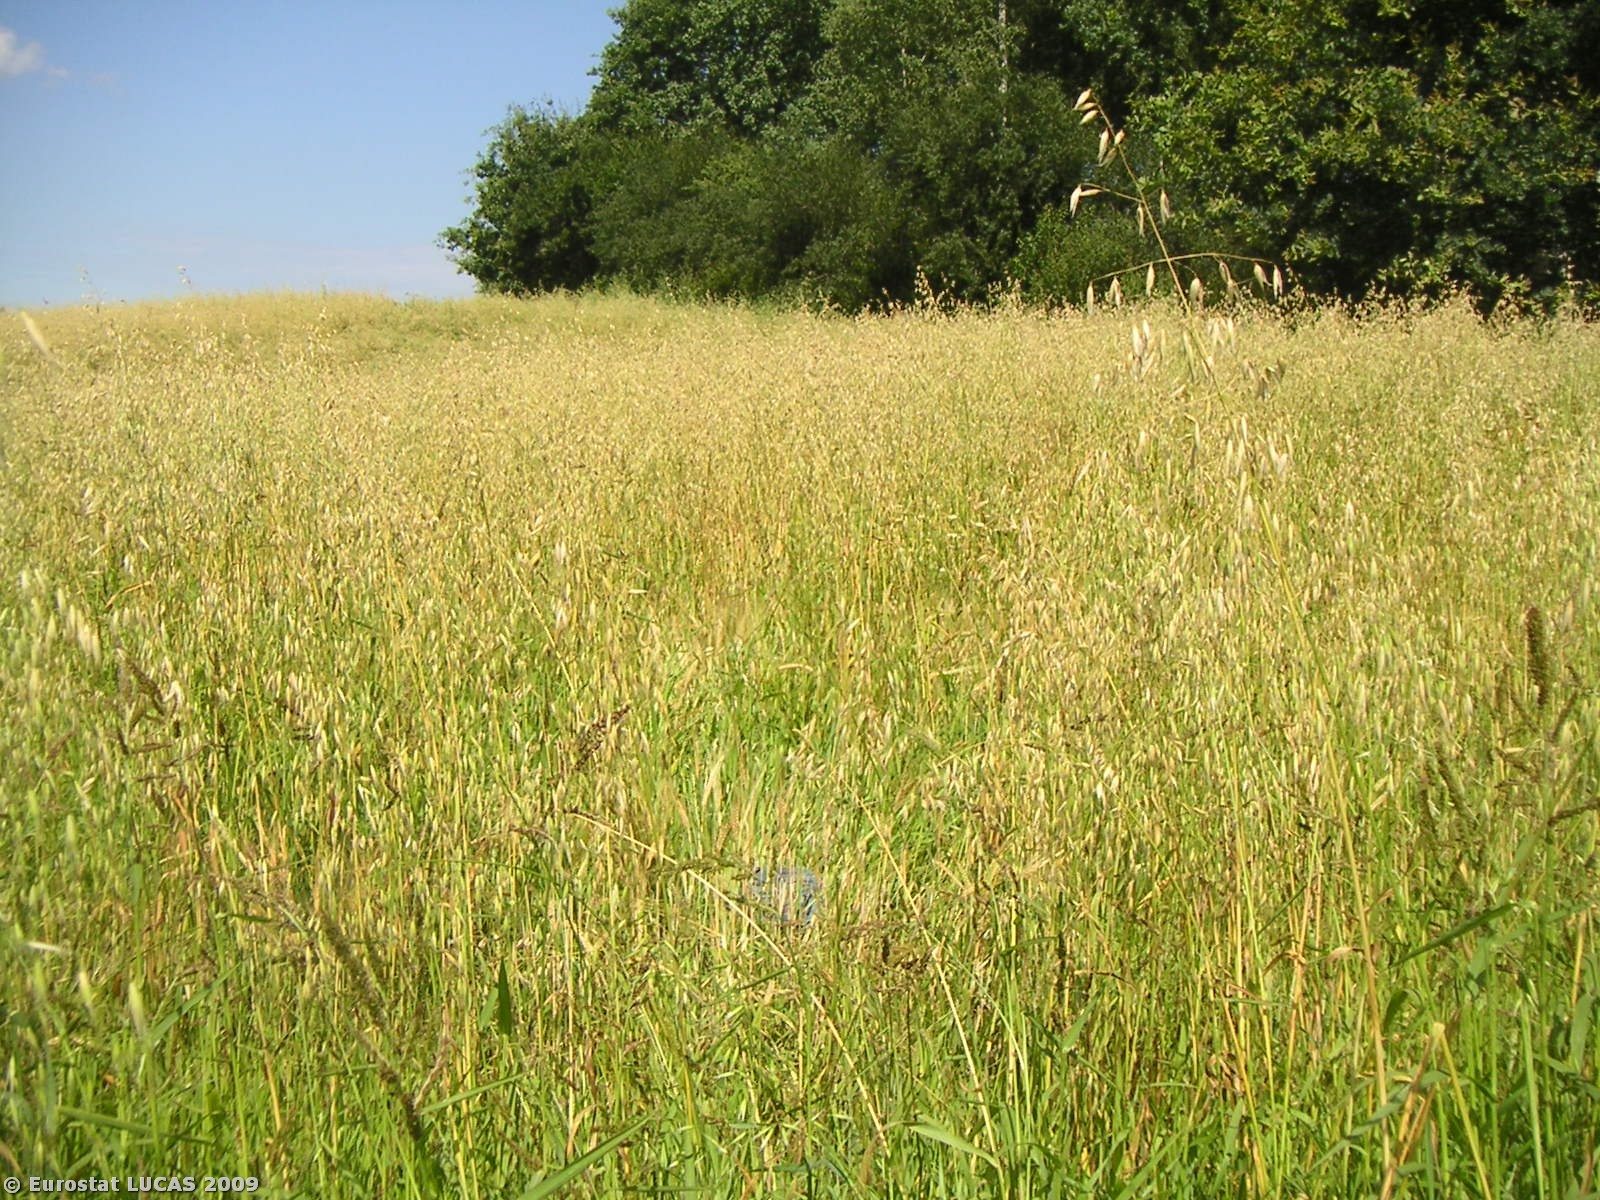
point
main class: Cropland
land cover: Oats
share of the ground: 50 - 75 %
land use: Agriculture (excluding fallow land and kitchen gardens)
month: July
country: PL
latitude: 50.0030
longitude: 19.7260
